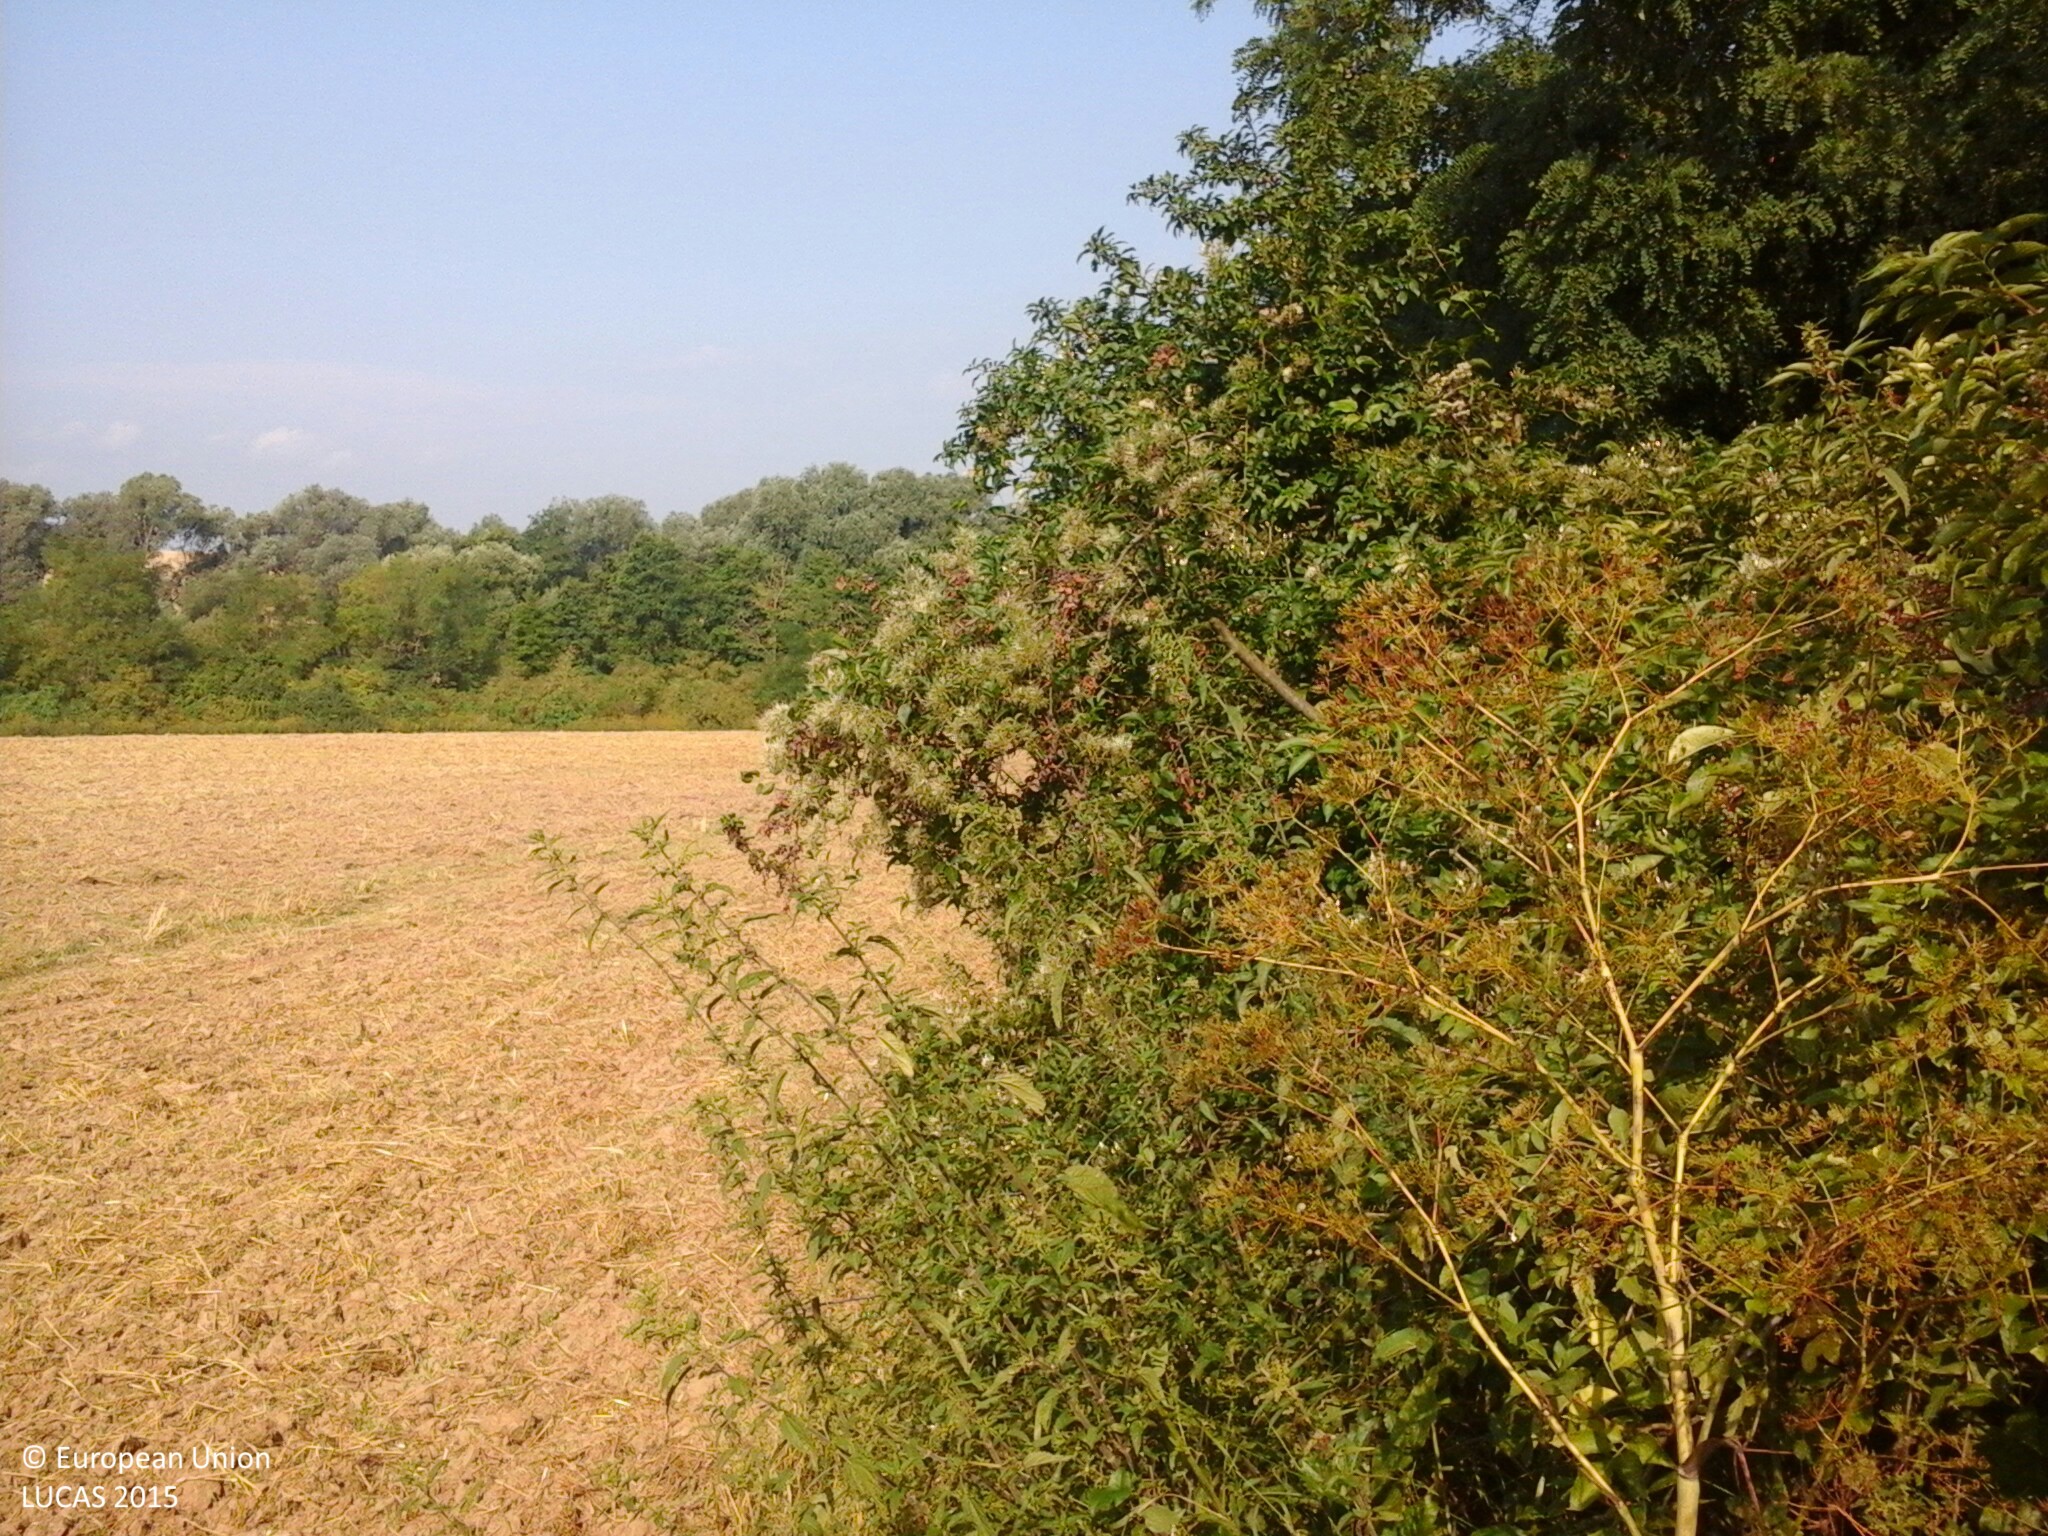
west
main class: Woodland
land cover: Broadleaved woodland
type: mesophytic deciduous forest
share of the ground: 50 - 75 %
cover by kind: broadleaved forest trees 60 %, shrubs 25 %, herbaceous plants 15 %
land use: Forestry
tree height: > 5 m
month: August
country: HU
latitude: 47.3364
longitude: 17.9904
